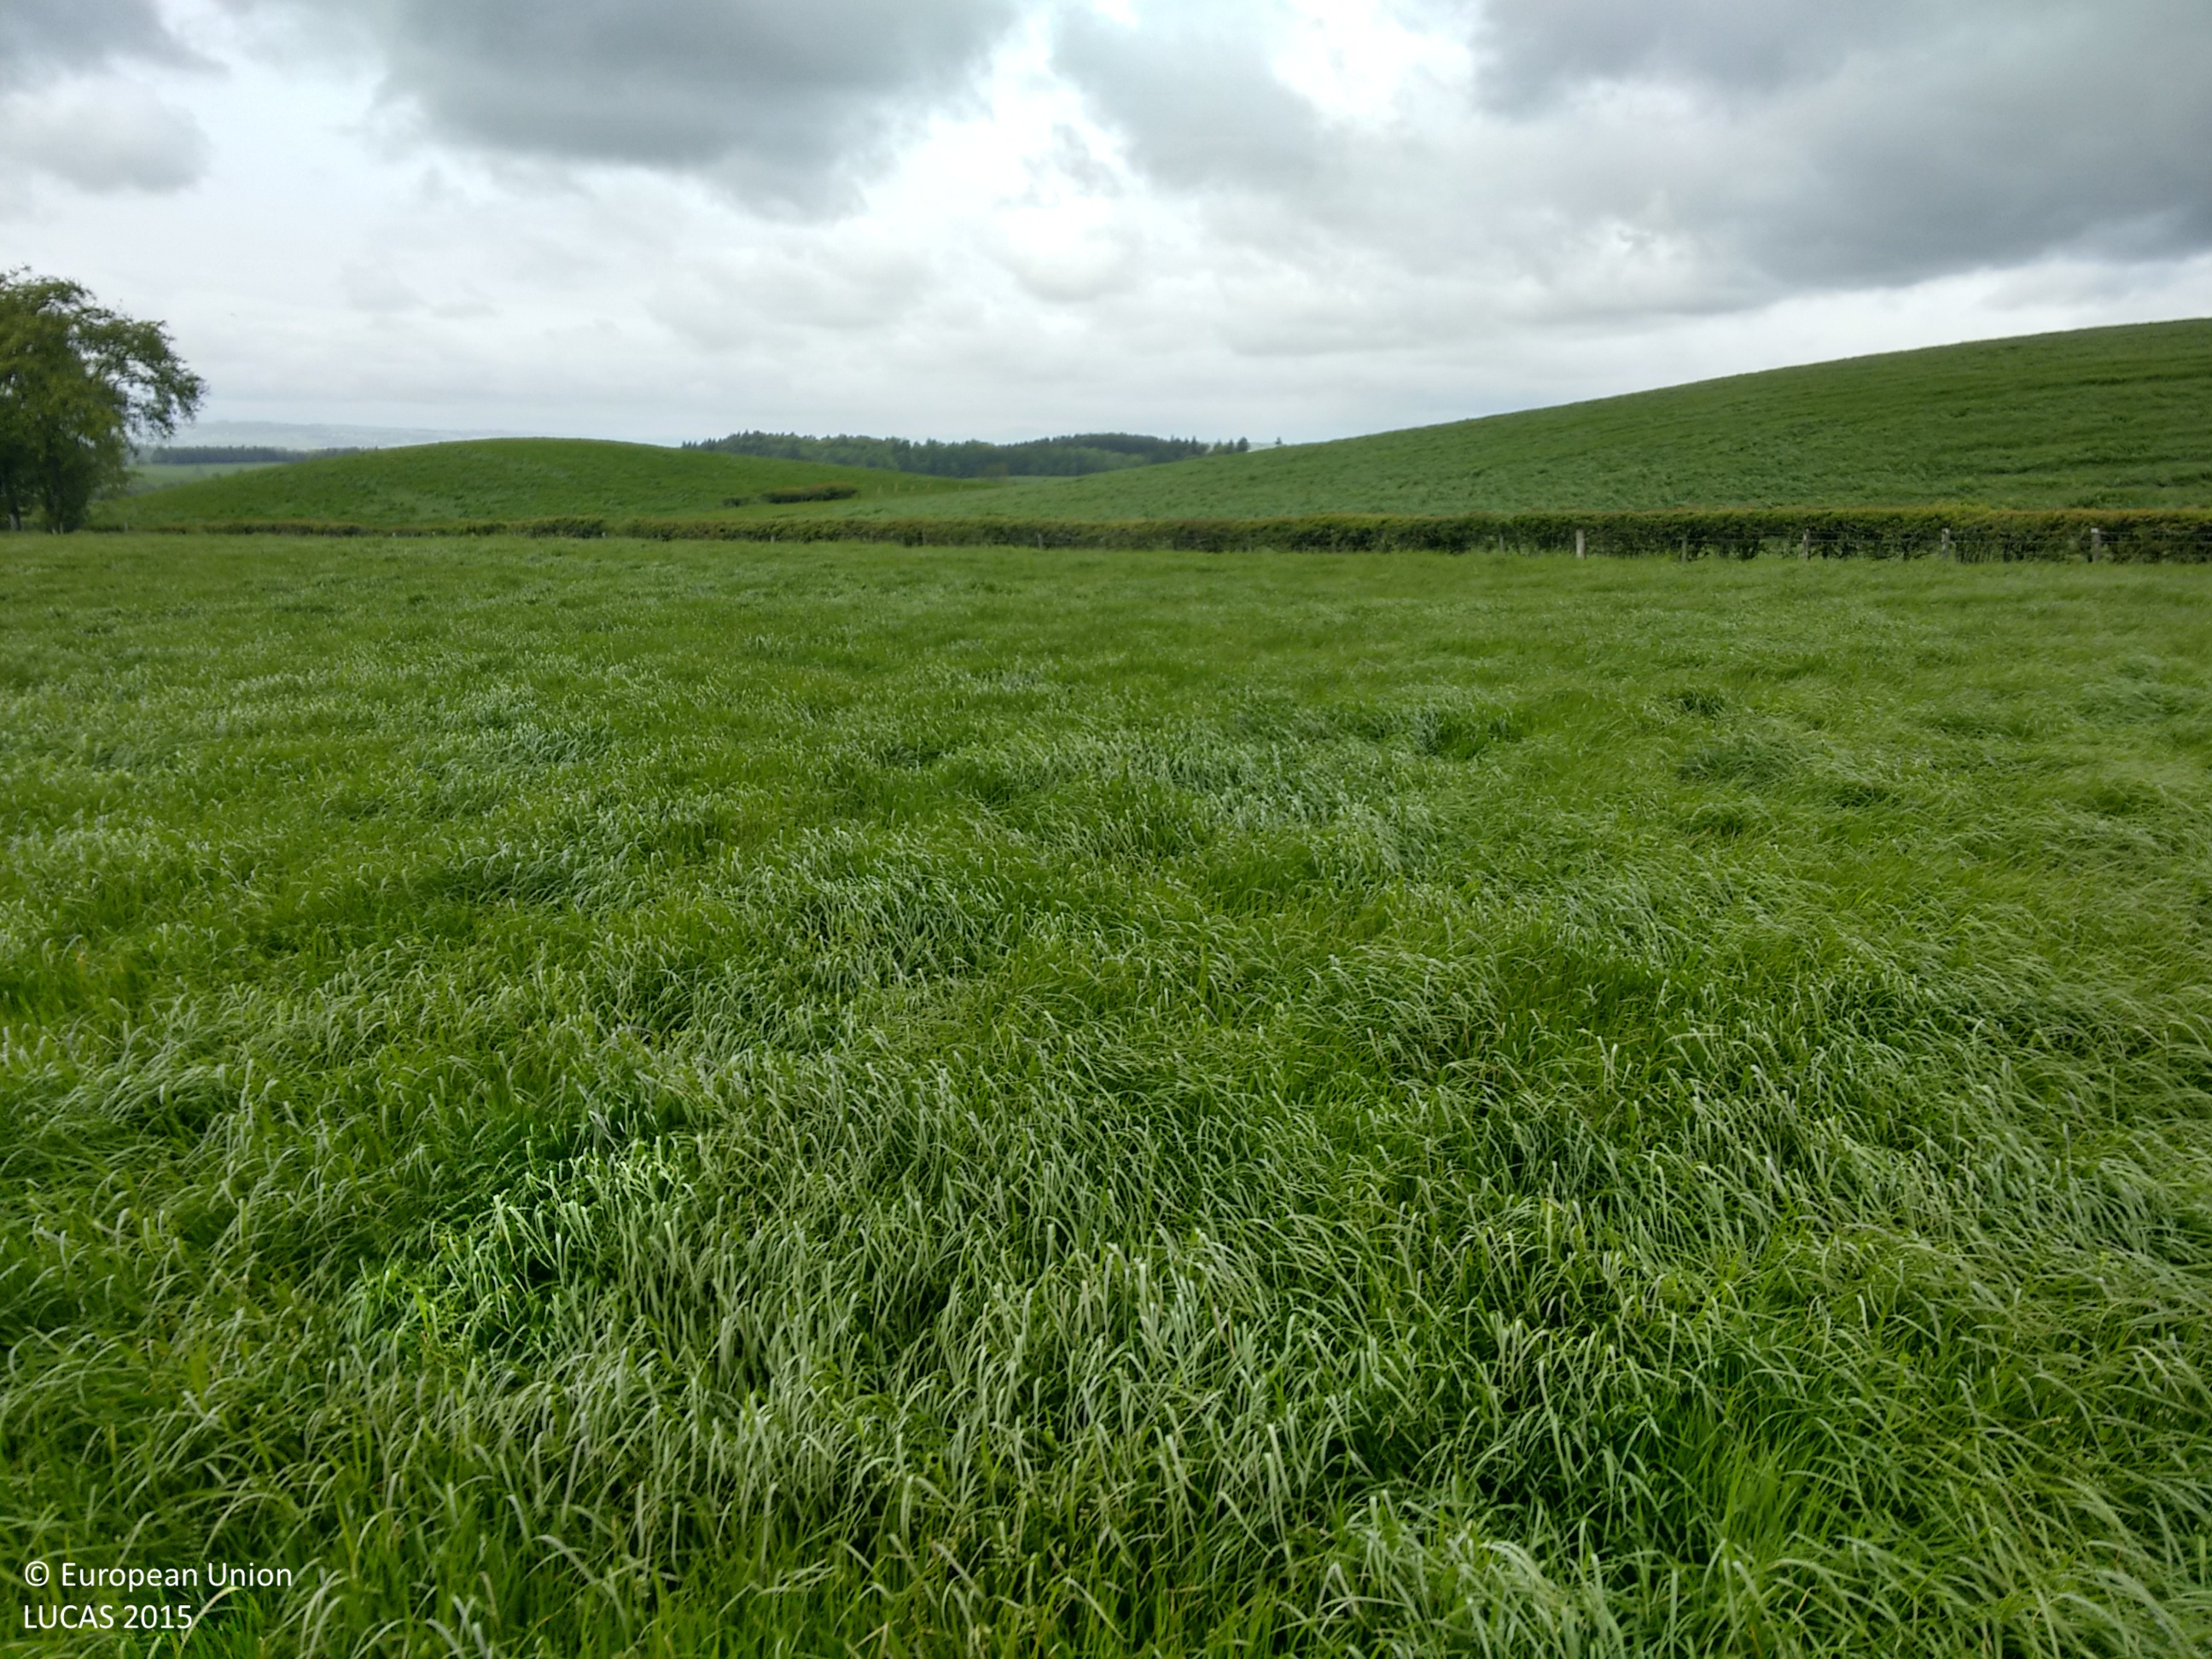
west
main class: Grassland
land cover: Grassland without tree/shrub cover
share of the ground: > 75 %
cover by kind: herbaceous plants 100 %
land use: Agriculture (excluding fallow land and kitchen gardens)
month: June
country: GB
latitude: 56.2015
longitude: -3.9969
